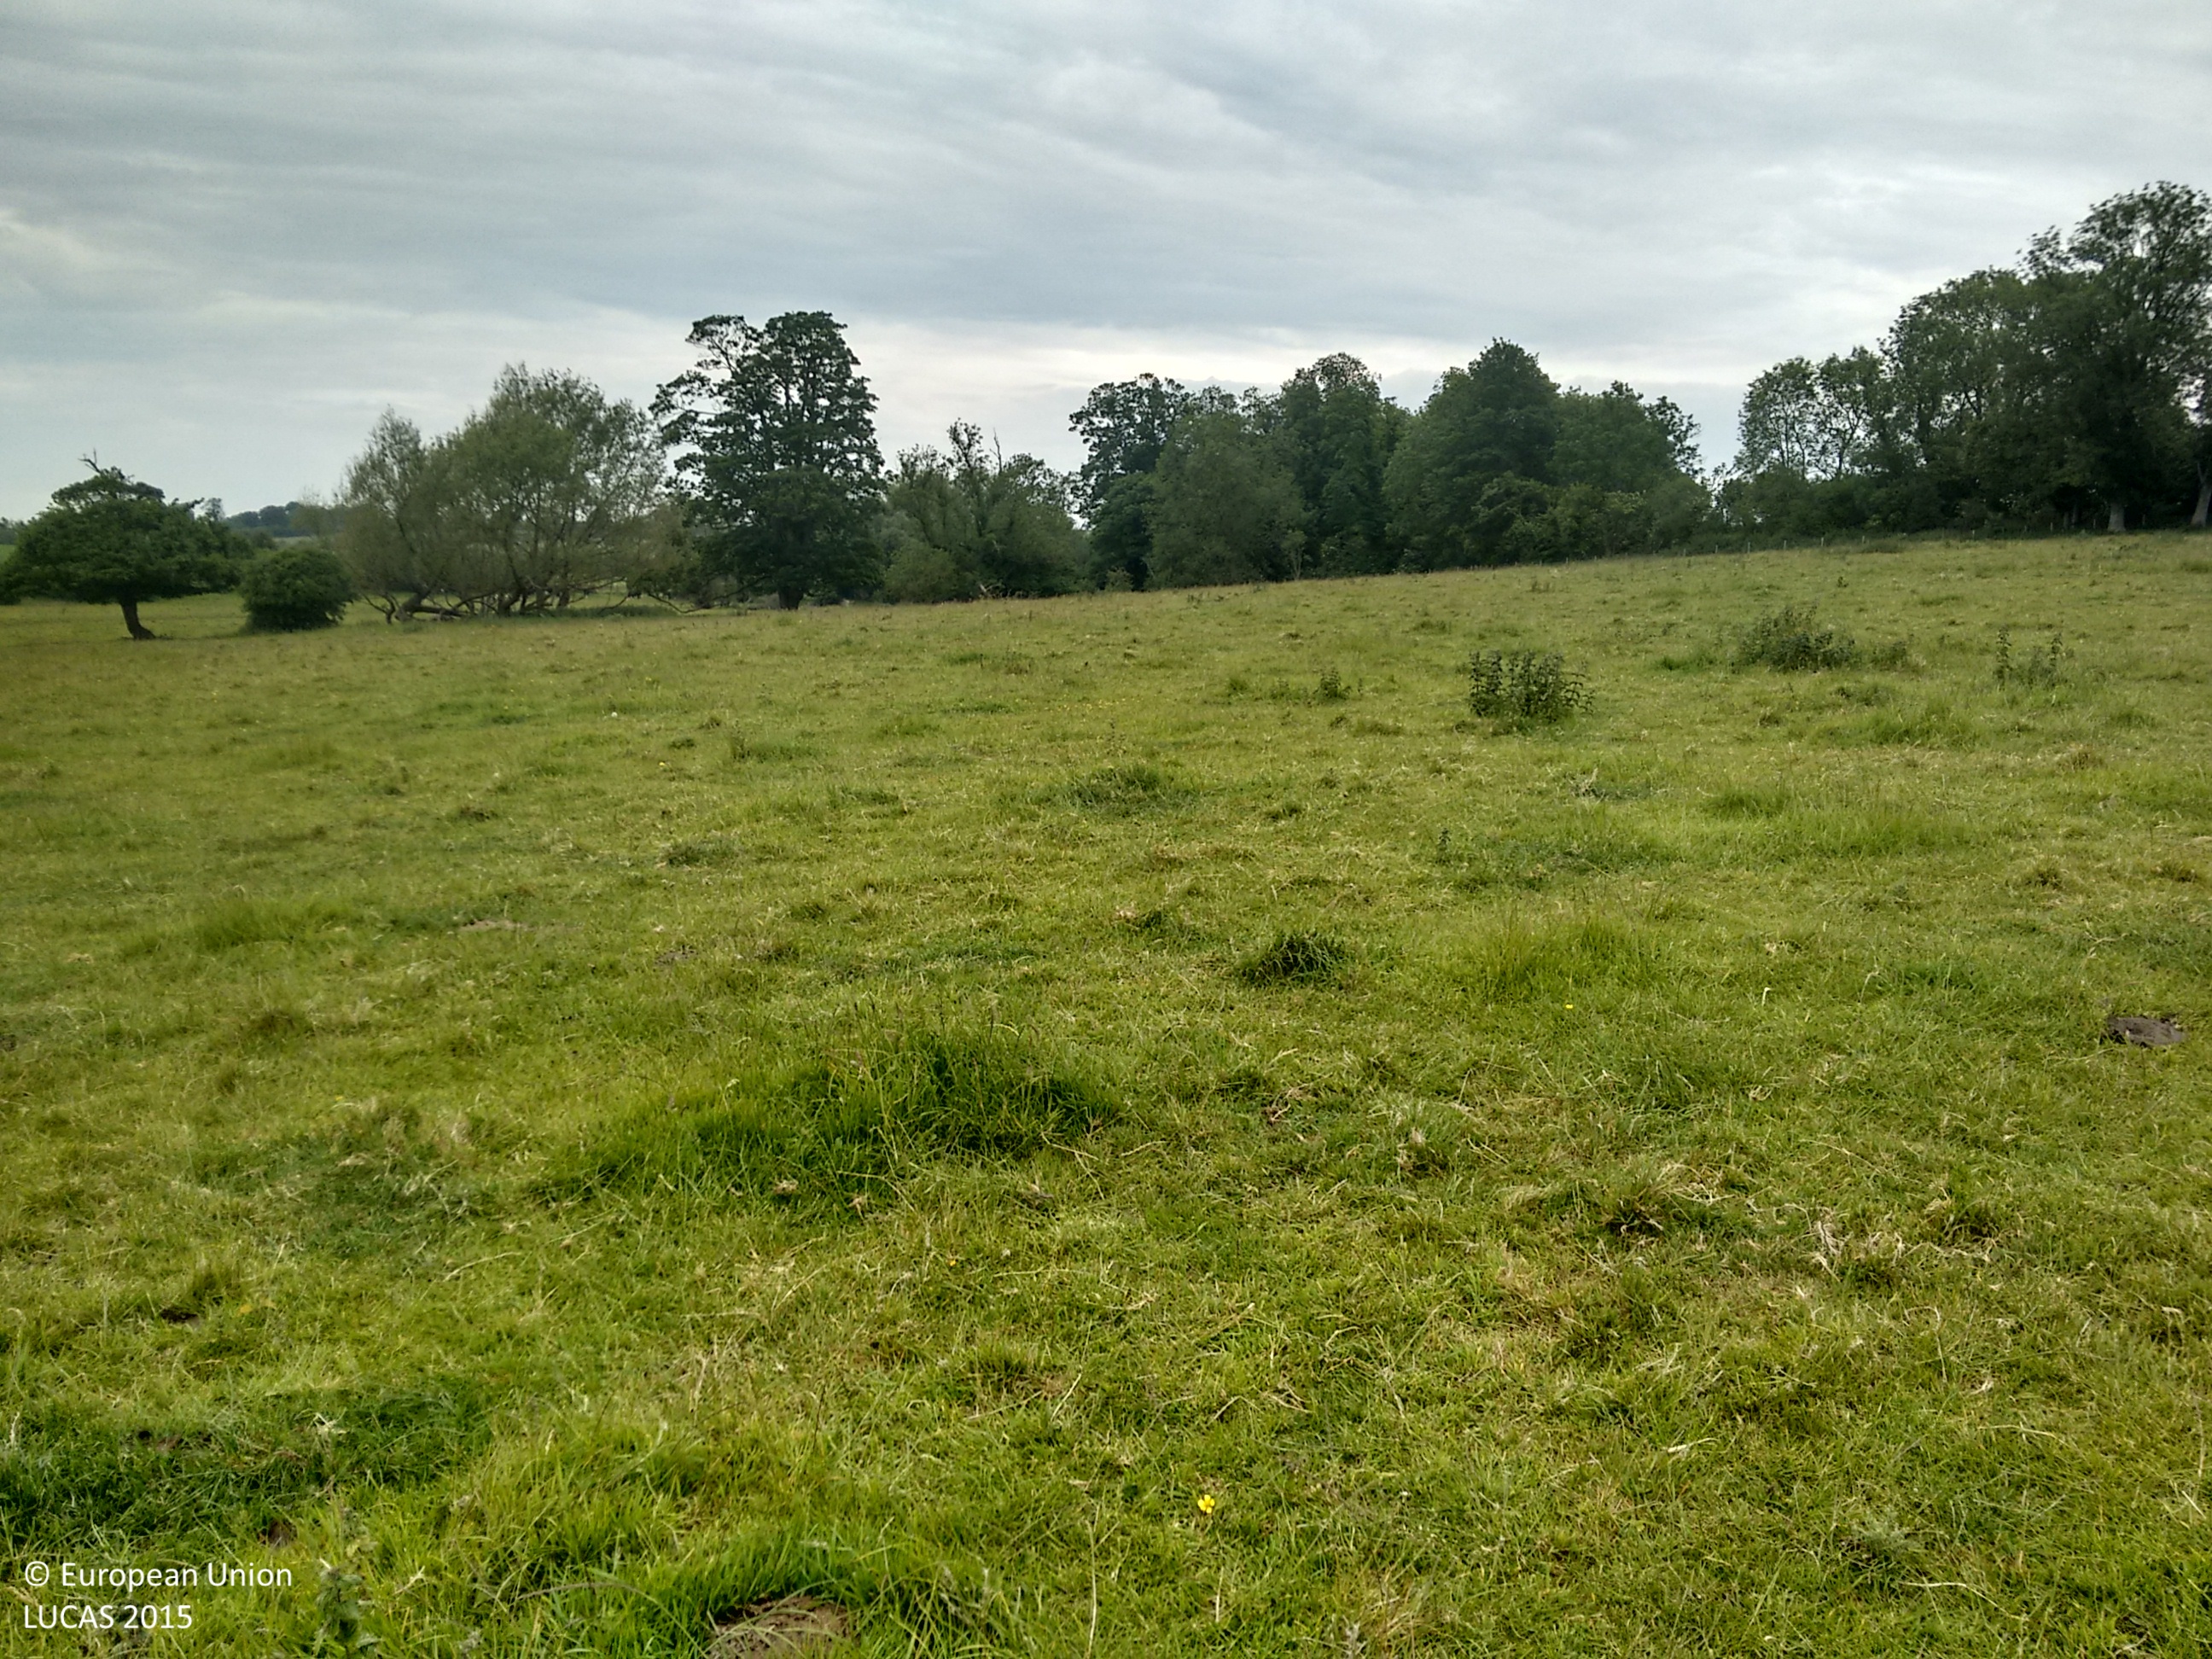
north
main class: Grassland
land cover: Grassland without tree/shrub cover
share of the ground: > 75 %
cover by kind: herbaceous plants 100 %
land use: Agriculture (excluding fallow land and kitchen gardens)
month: June
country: GB
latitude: 51.1778
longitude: -1.8866
